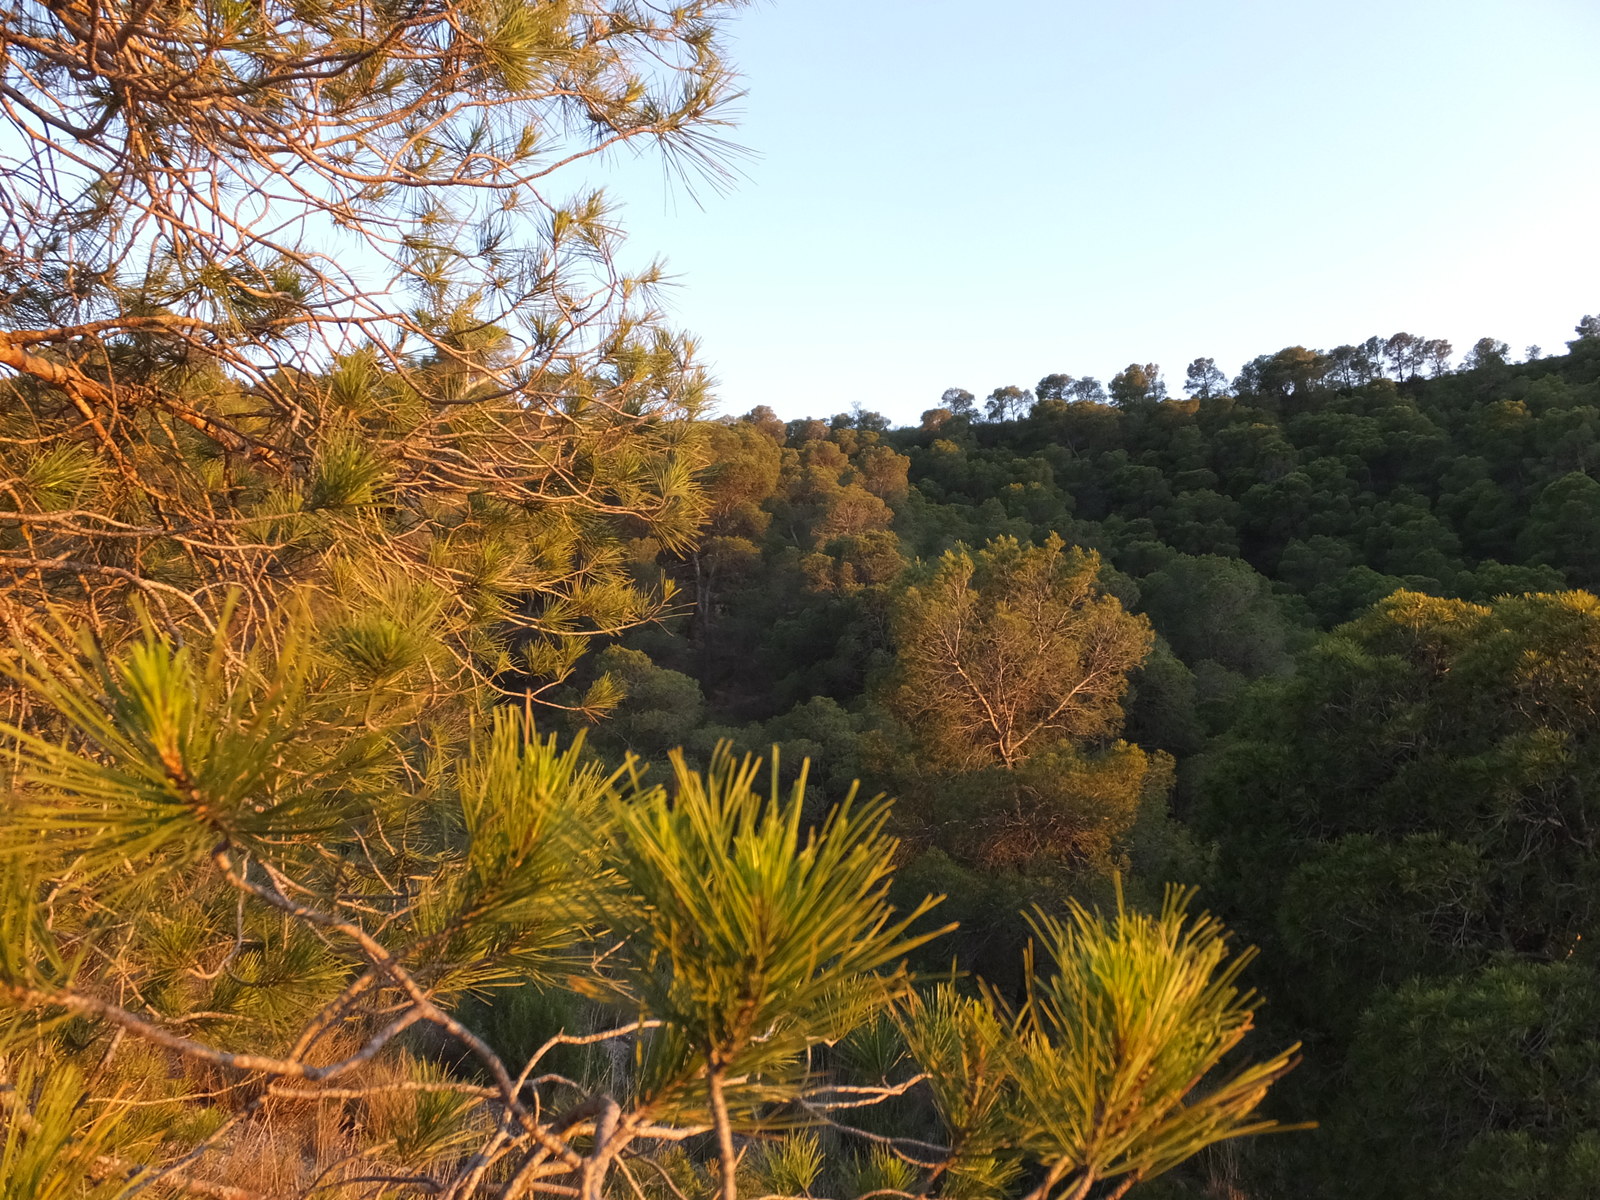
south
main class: Woodland
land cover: Pine dominated mixed woodland
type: coniferous forest of the mediterranean region
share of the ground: 25 - 50 %
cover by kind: shrubs 50 %, coniferous forest trees 25 %, broadleaved forest trees 15 %, herbaceous plants 10 %
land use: Forestry
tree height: < 5 m
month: June
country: ES
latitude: 41.3494
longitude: -0.2575
